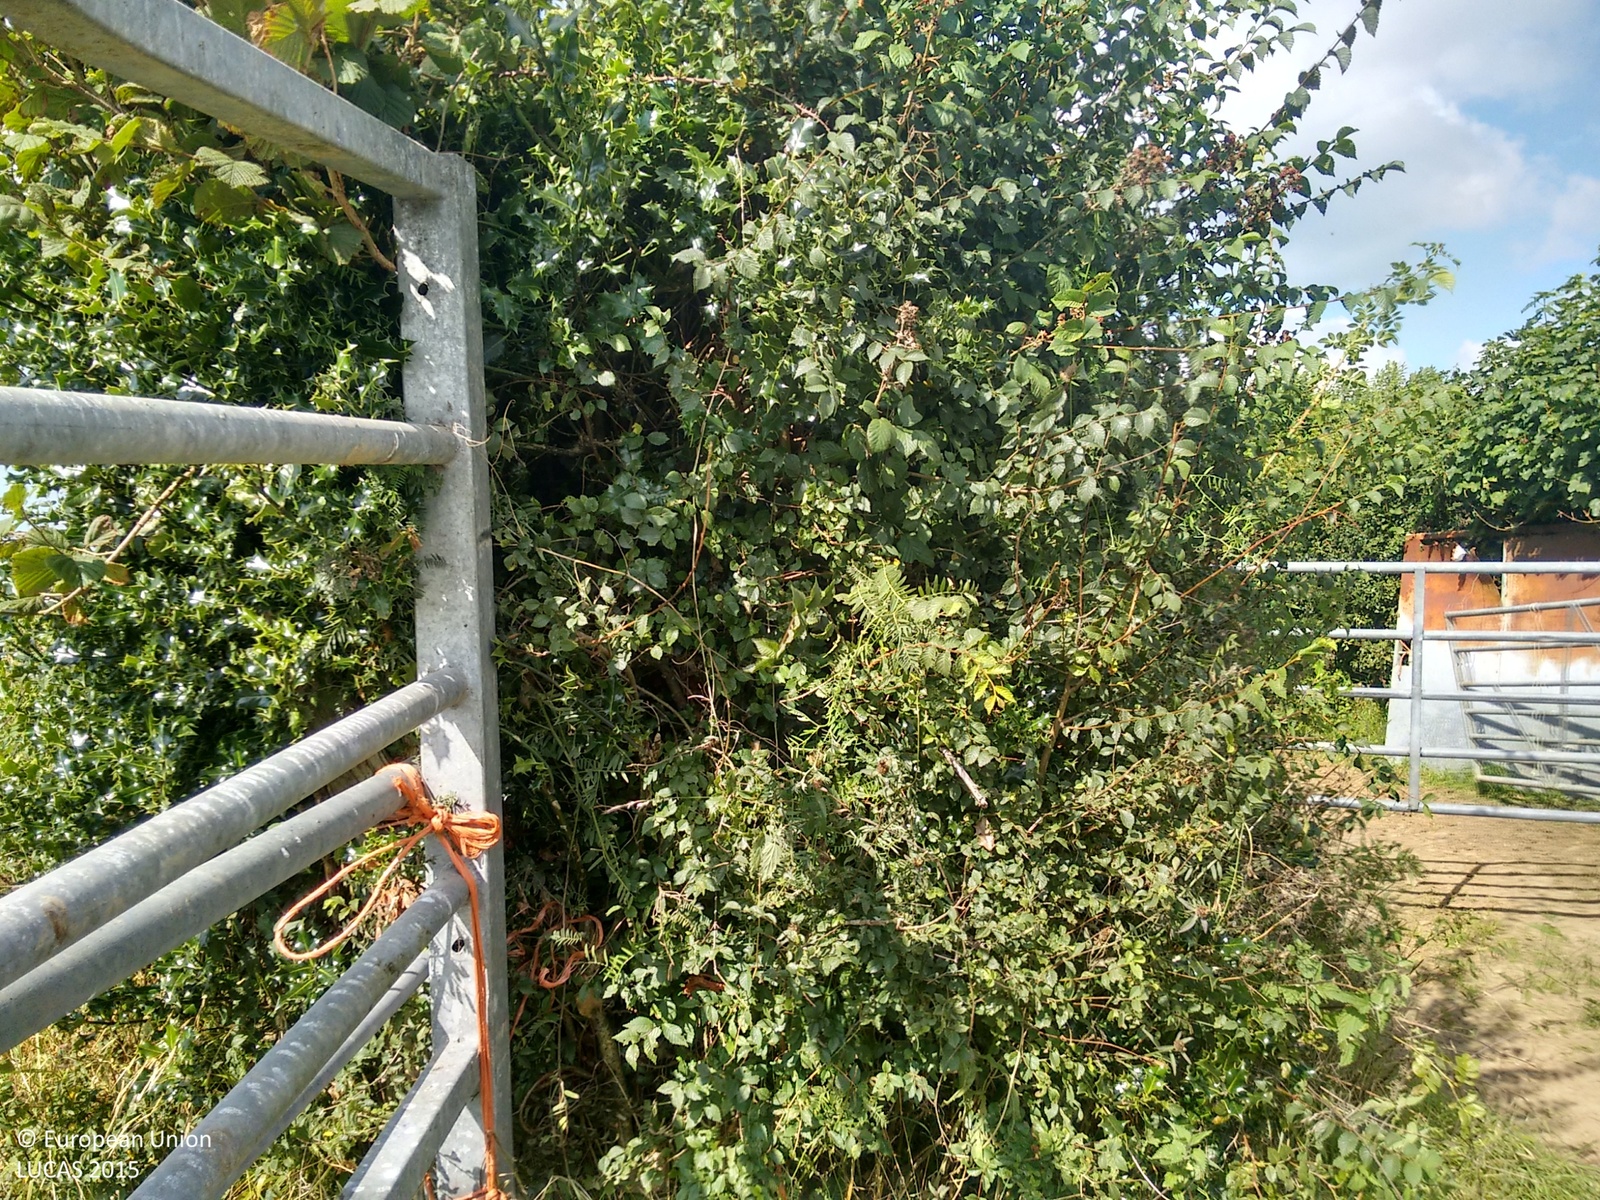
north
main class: Cropland
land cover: Barley
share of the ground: > 75 %
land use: Agriculture (excluding fallow land and kitchen gardens)
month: September
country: GB
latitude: 50.9193
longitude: -4.1662
